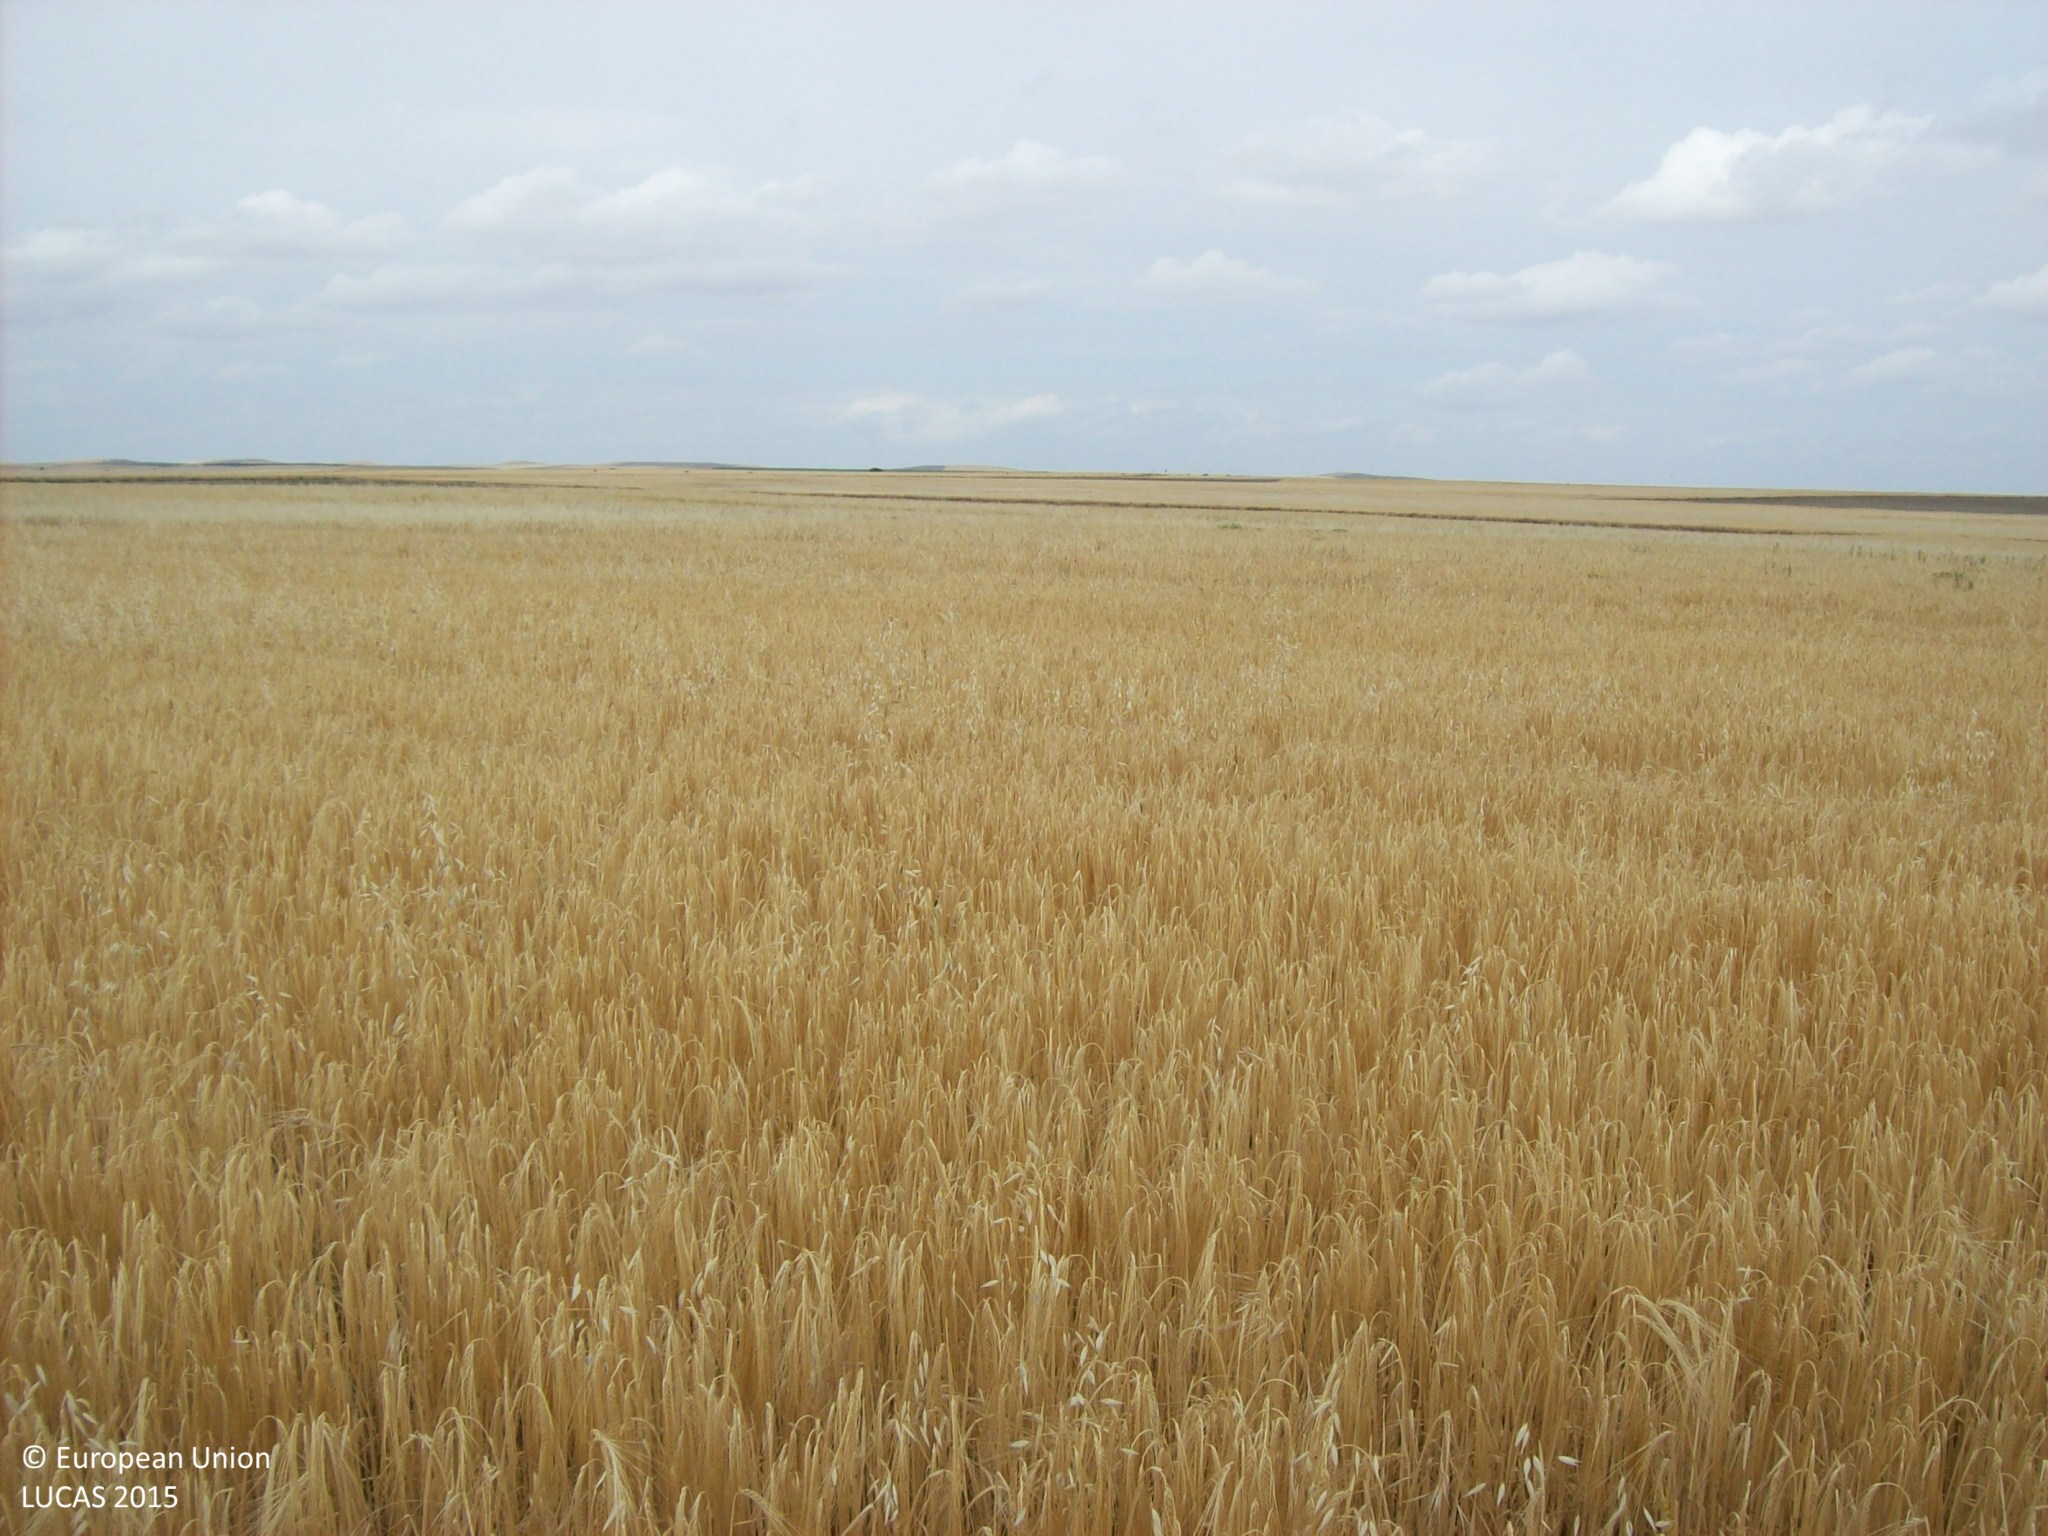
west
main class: Cropland
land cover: Barley
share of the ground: > 75 %
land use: Agriculture (excluding fallow land and kitchen gardens)
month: June
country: ES
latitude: 40.9646
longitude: -4.9765
